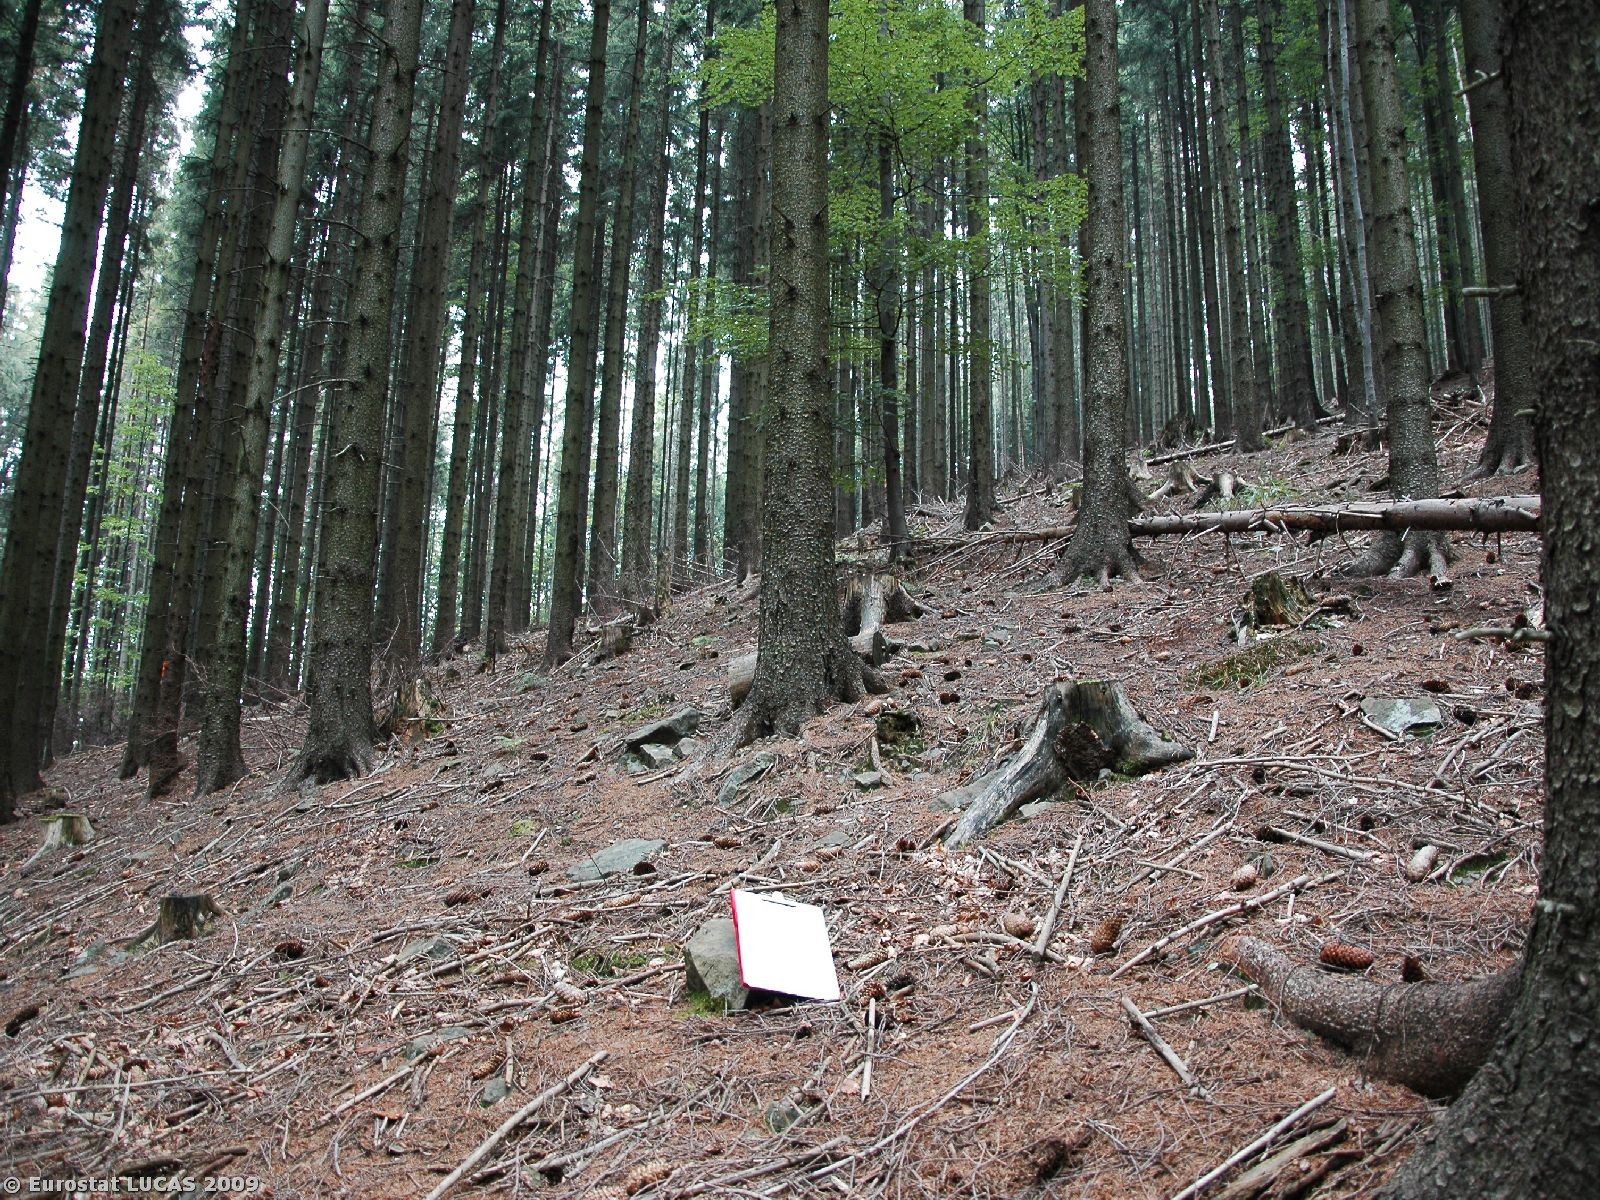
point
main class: Woodland
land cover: Coniferous woodland
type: hemiboreal forest and nemoral coniferous forest and mixed broadleaved-coniferous forest
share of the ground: 50 - 75 %
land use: Forestry
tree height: > 5 m
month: August
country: PL
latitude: 49.4275
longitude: 19.0257
